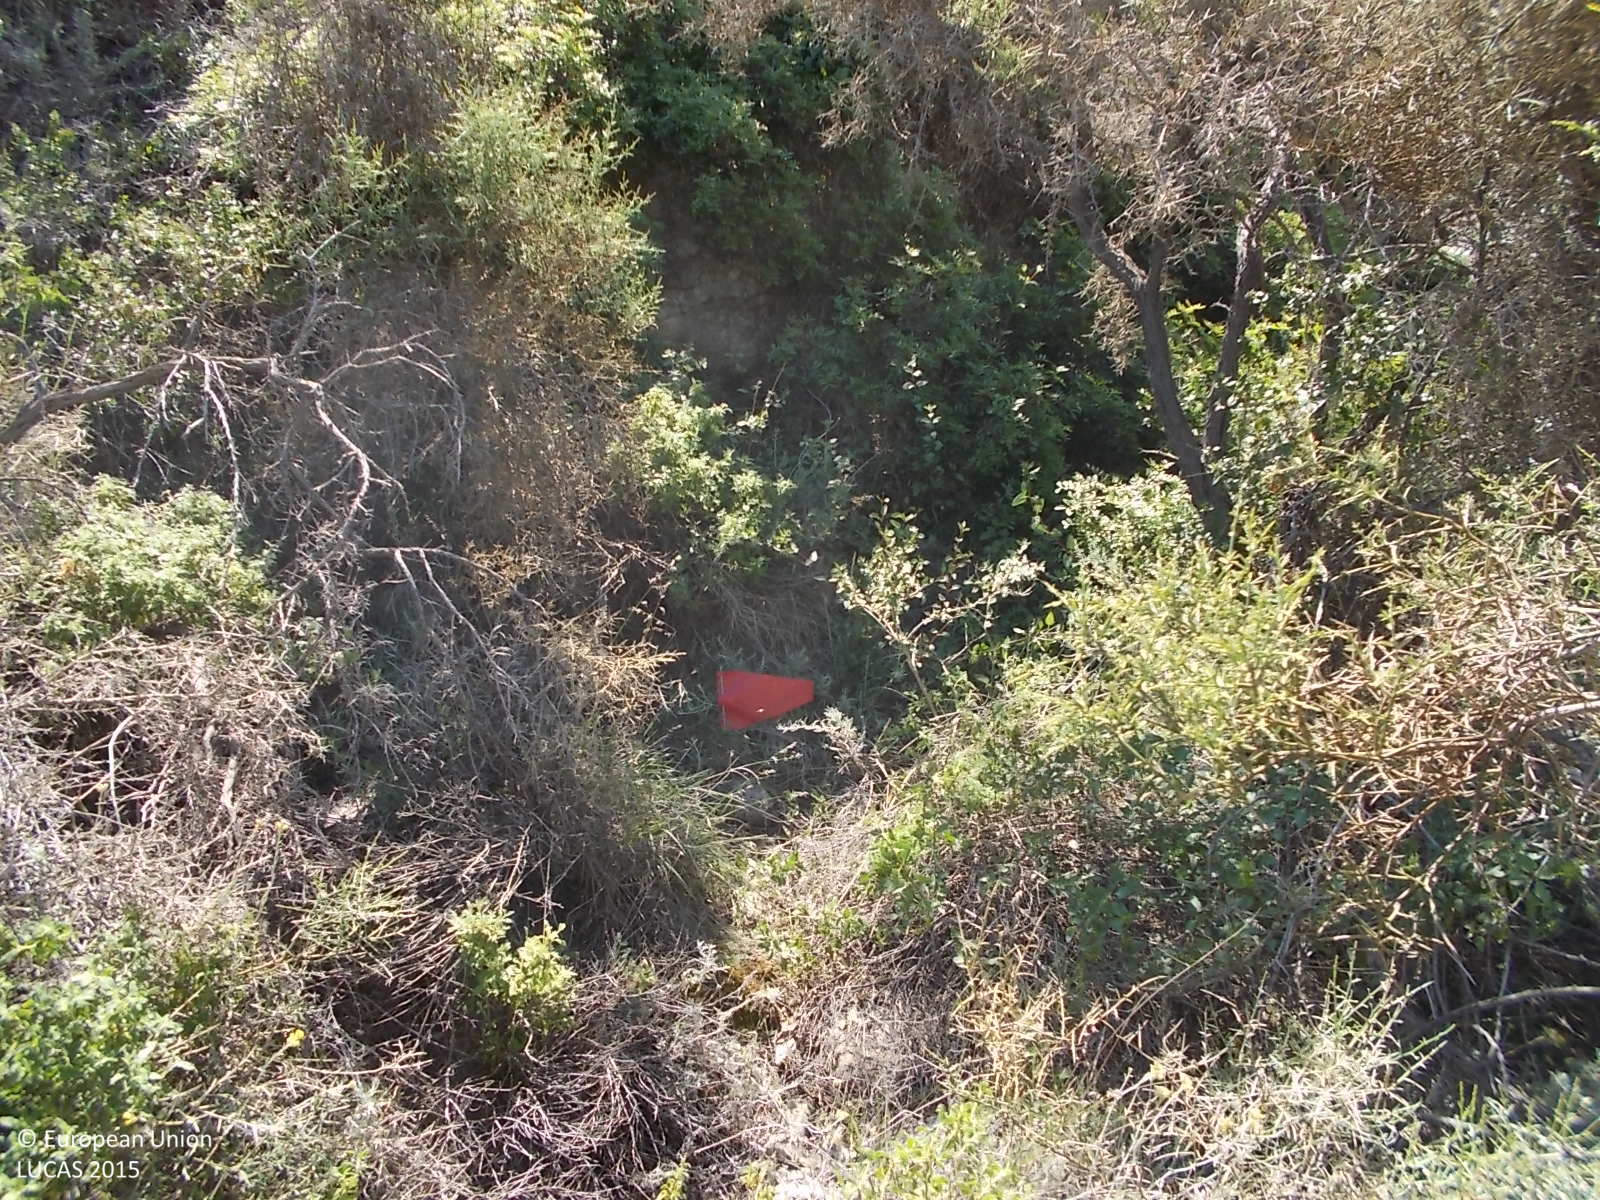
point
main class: Shrubland
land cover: Shrubland without tree cover
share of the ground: > 75 %
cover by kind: shrubs 100 %
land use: Semi-natural and natural areas not in use
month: April
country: CY
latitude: 34.7262
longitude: 33.0448
